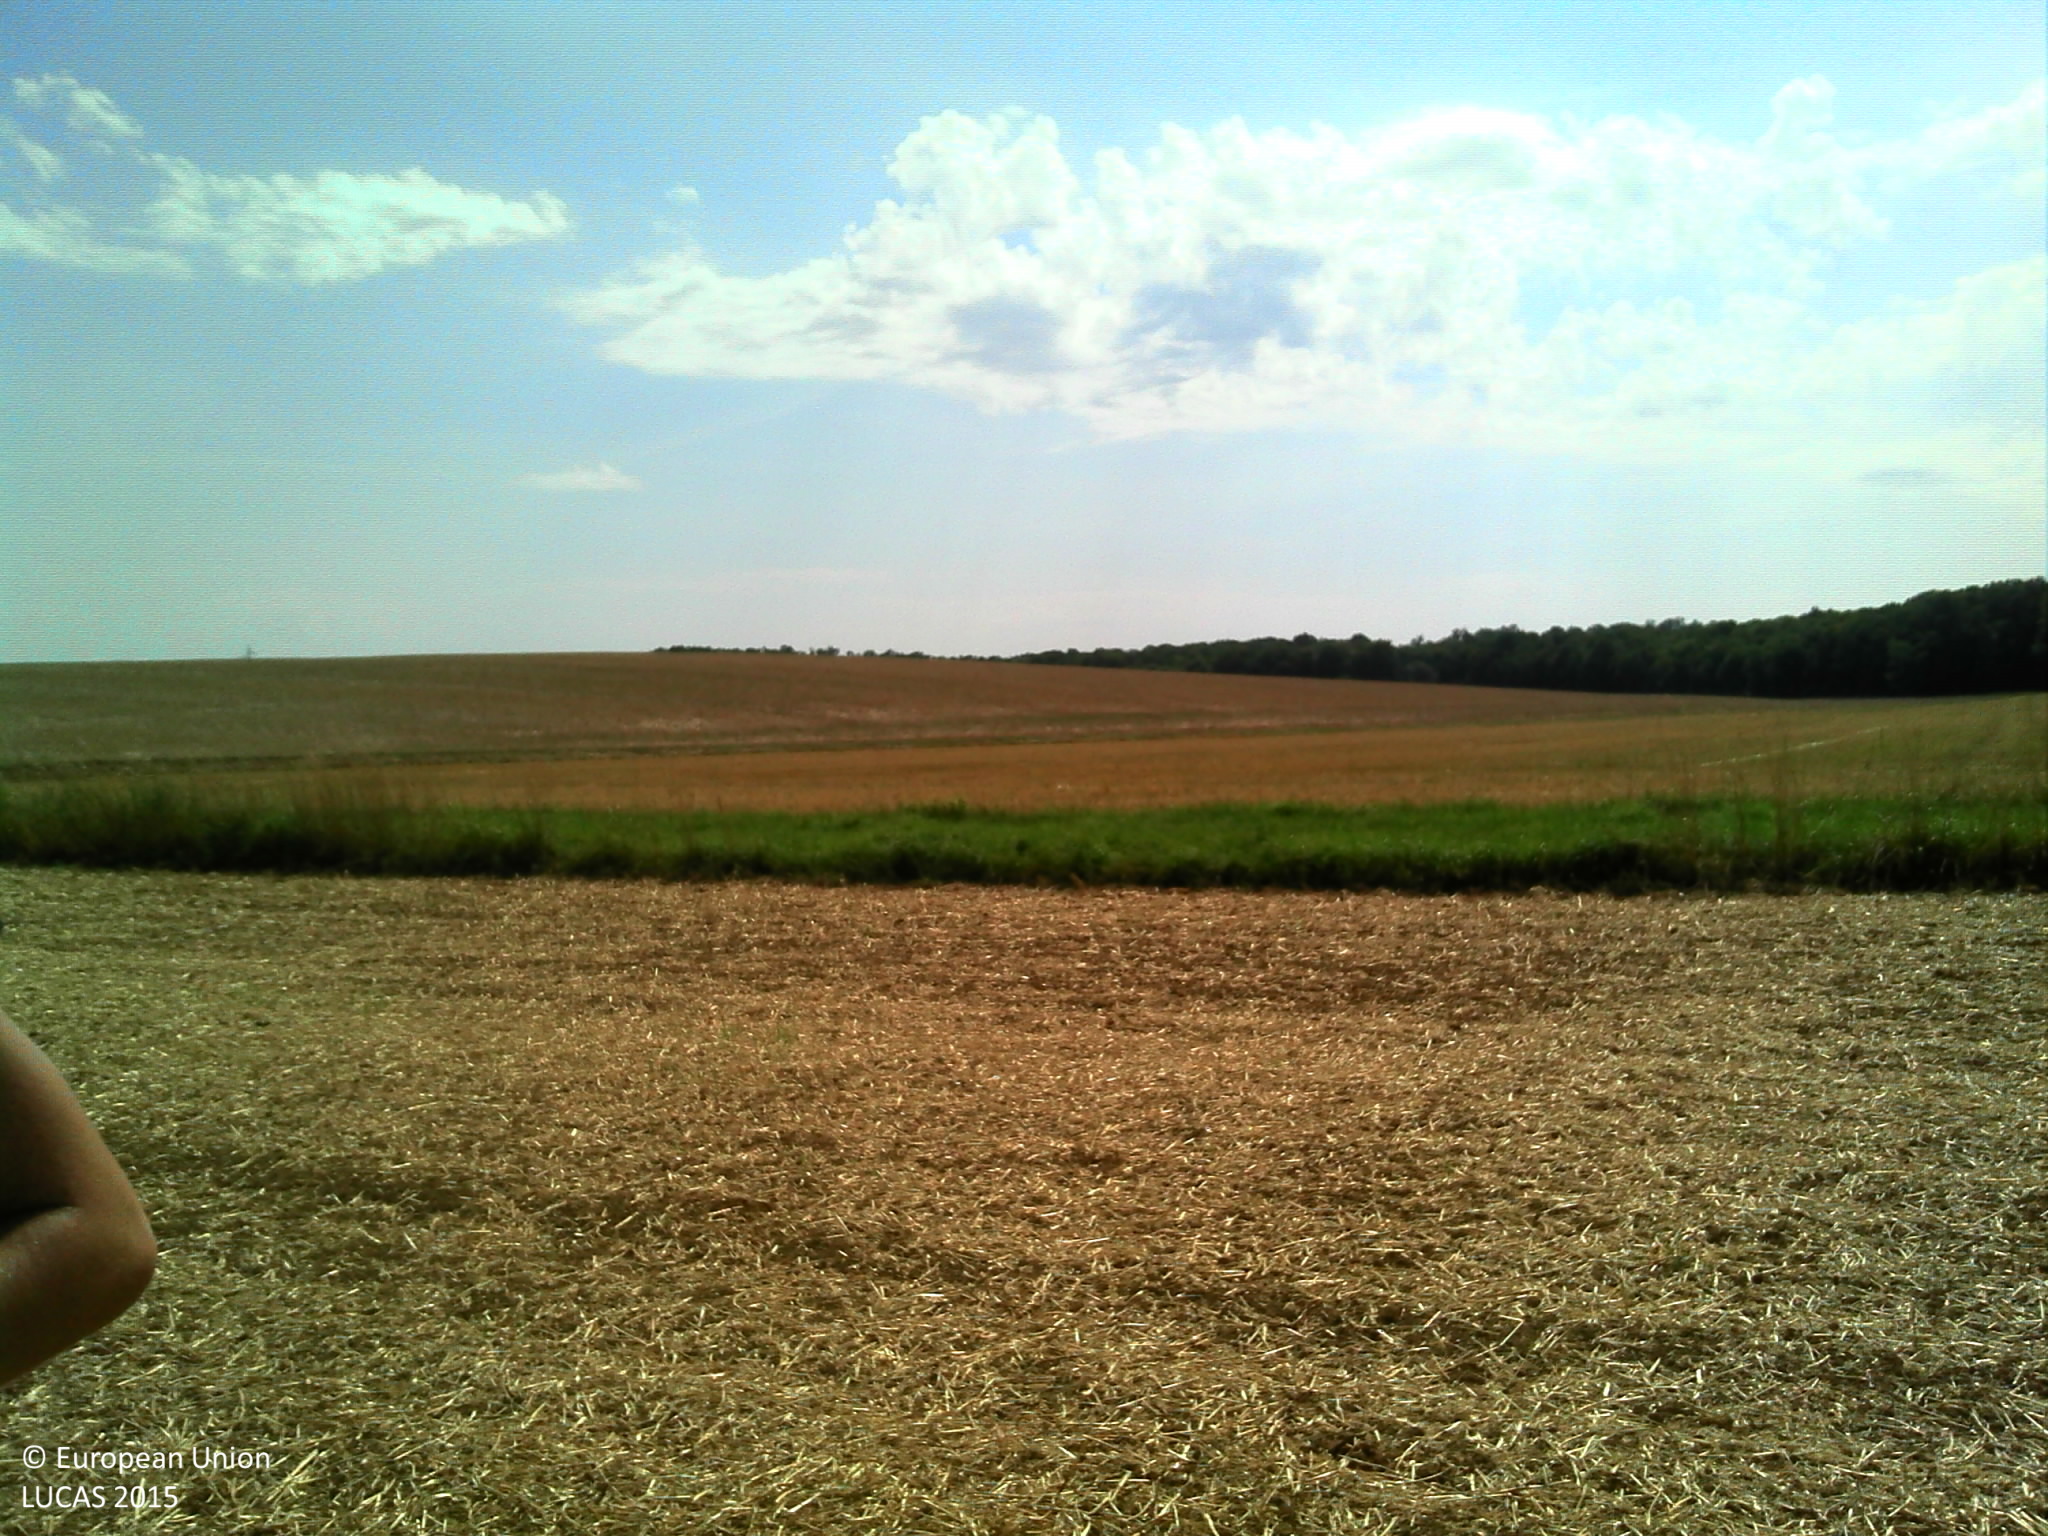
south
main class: Cropland
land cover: Rye
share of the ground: 10 - 25 %
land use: Agriculture (excluding fallow land and kitchen gardens)
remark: Harvested field
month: August
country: FR
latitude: 48.5979
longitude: 5.0219
